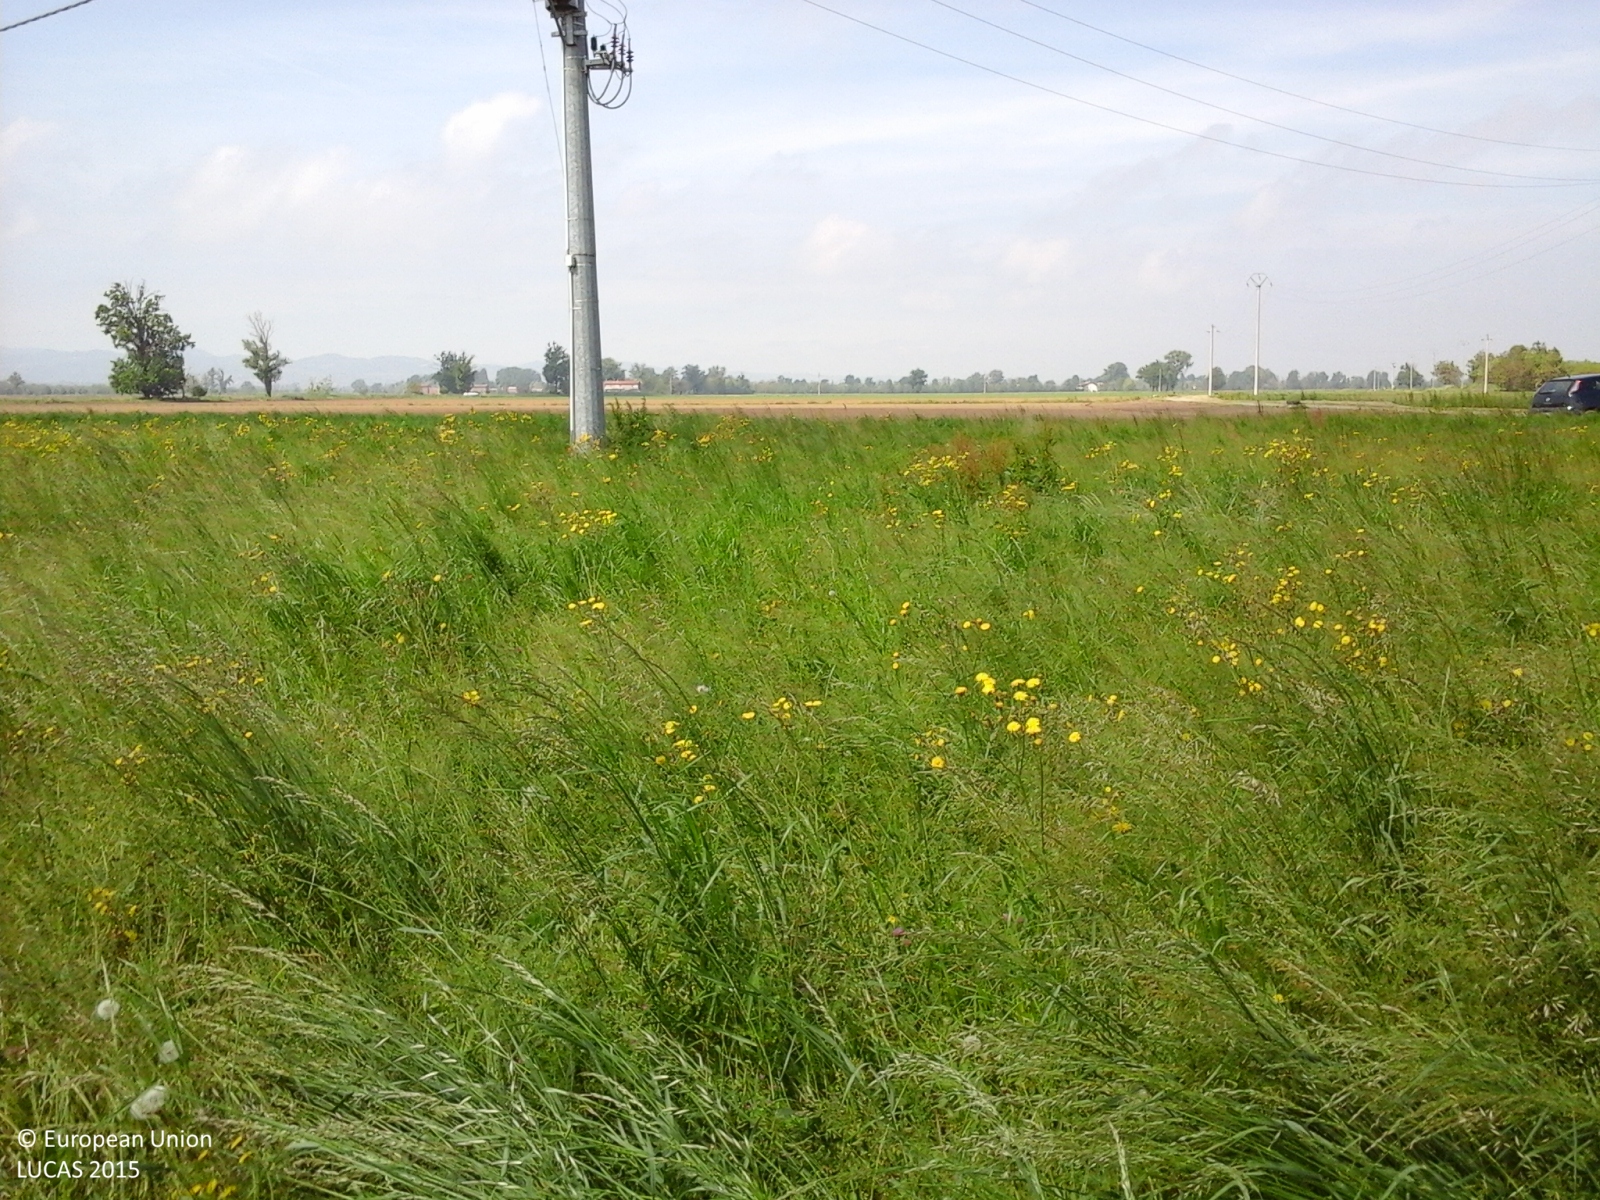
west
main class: Grassland
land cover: Grassland without tree/shrub cover
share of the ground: > 75 %
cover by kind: herbaceous plants 100 %
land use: Agriculture (excluding fallow land and kitchen gardens)
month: May
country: IT
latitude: 44.9810
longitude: 9.6330
